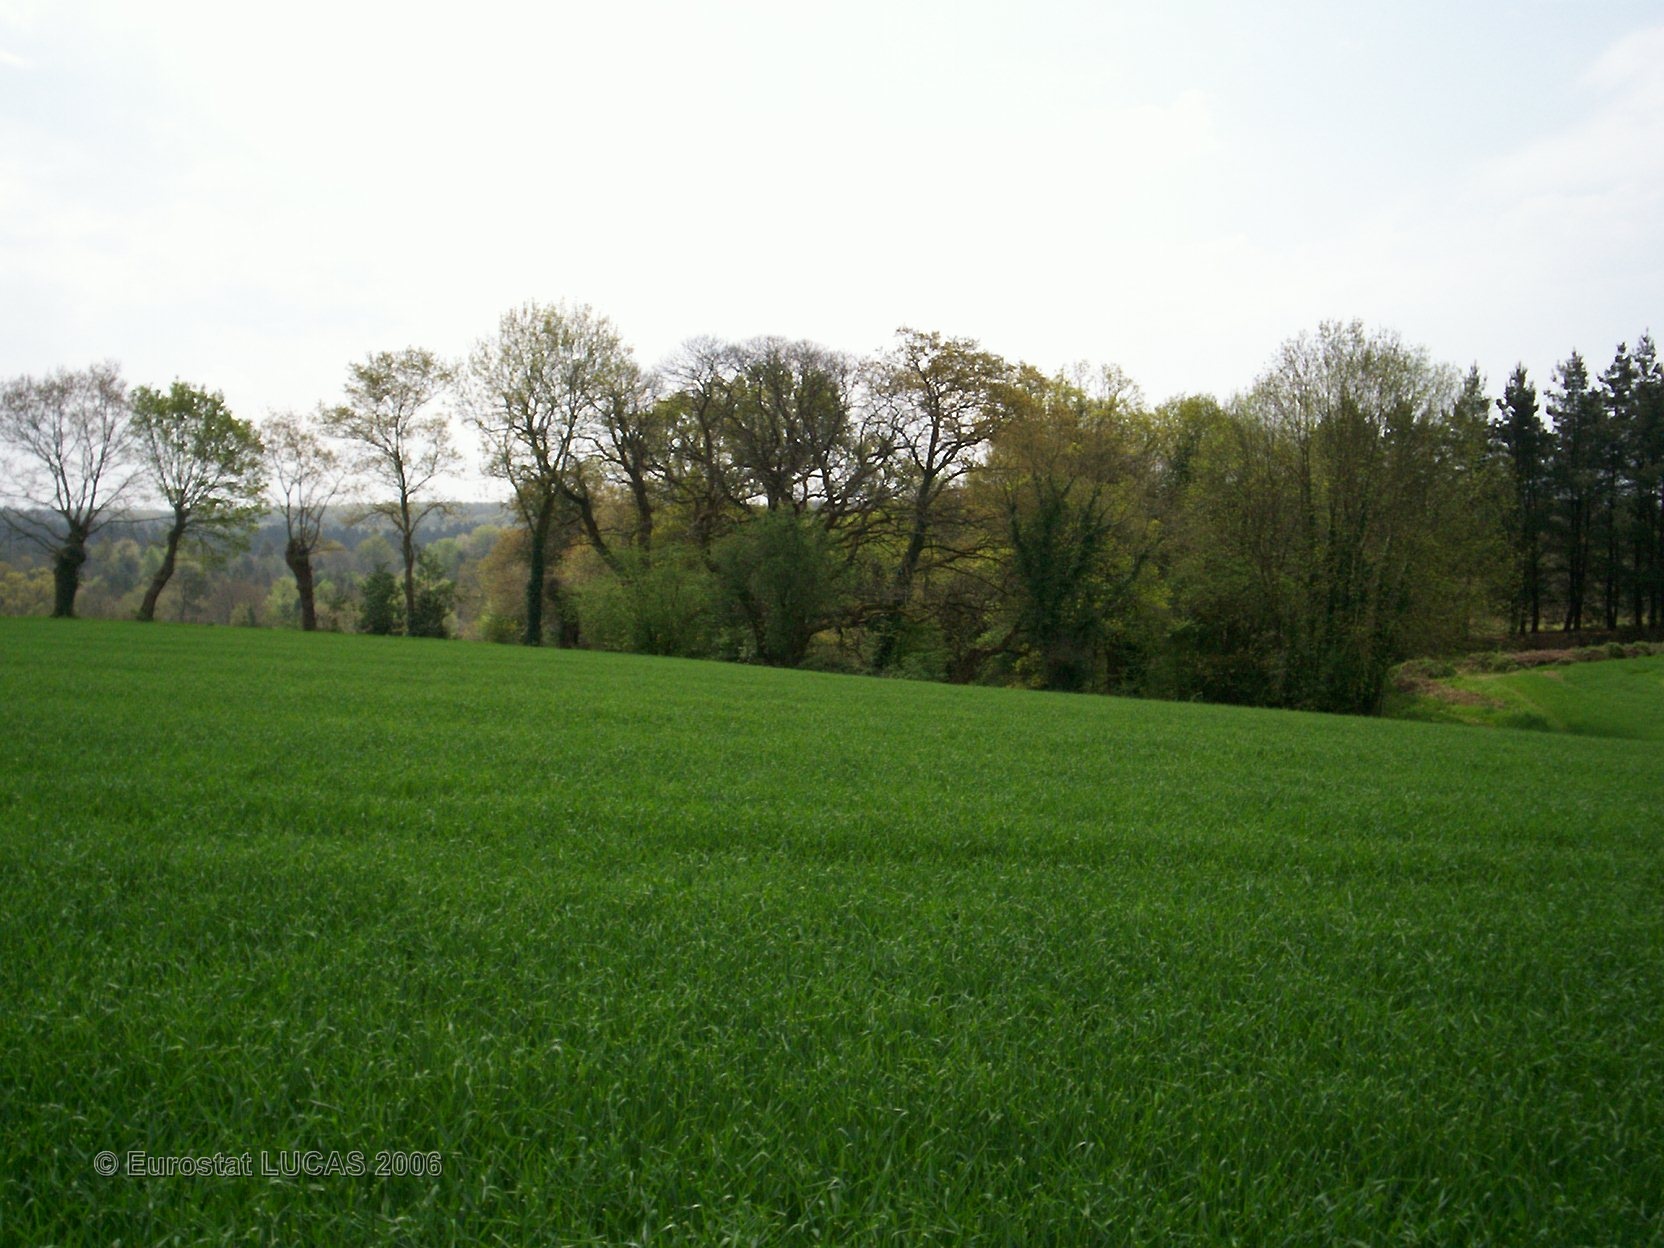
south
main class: Cropland
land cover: Barley
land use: Agriculture (excluding fallow land and kitchen gardens)
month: May
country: FR
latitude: 47.8123
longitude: -2.7085
